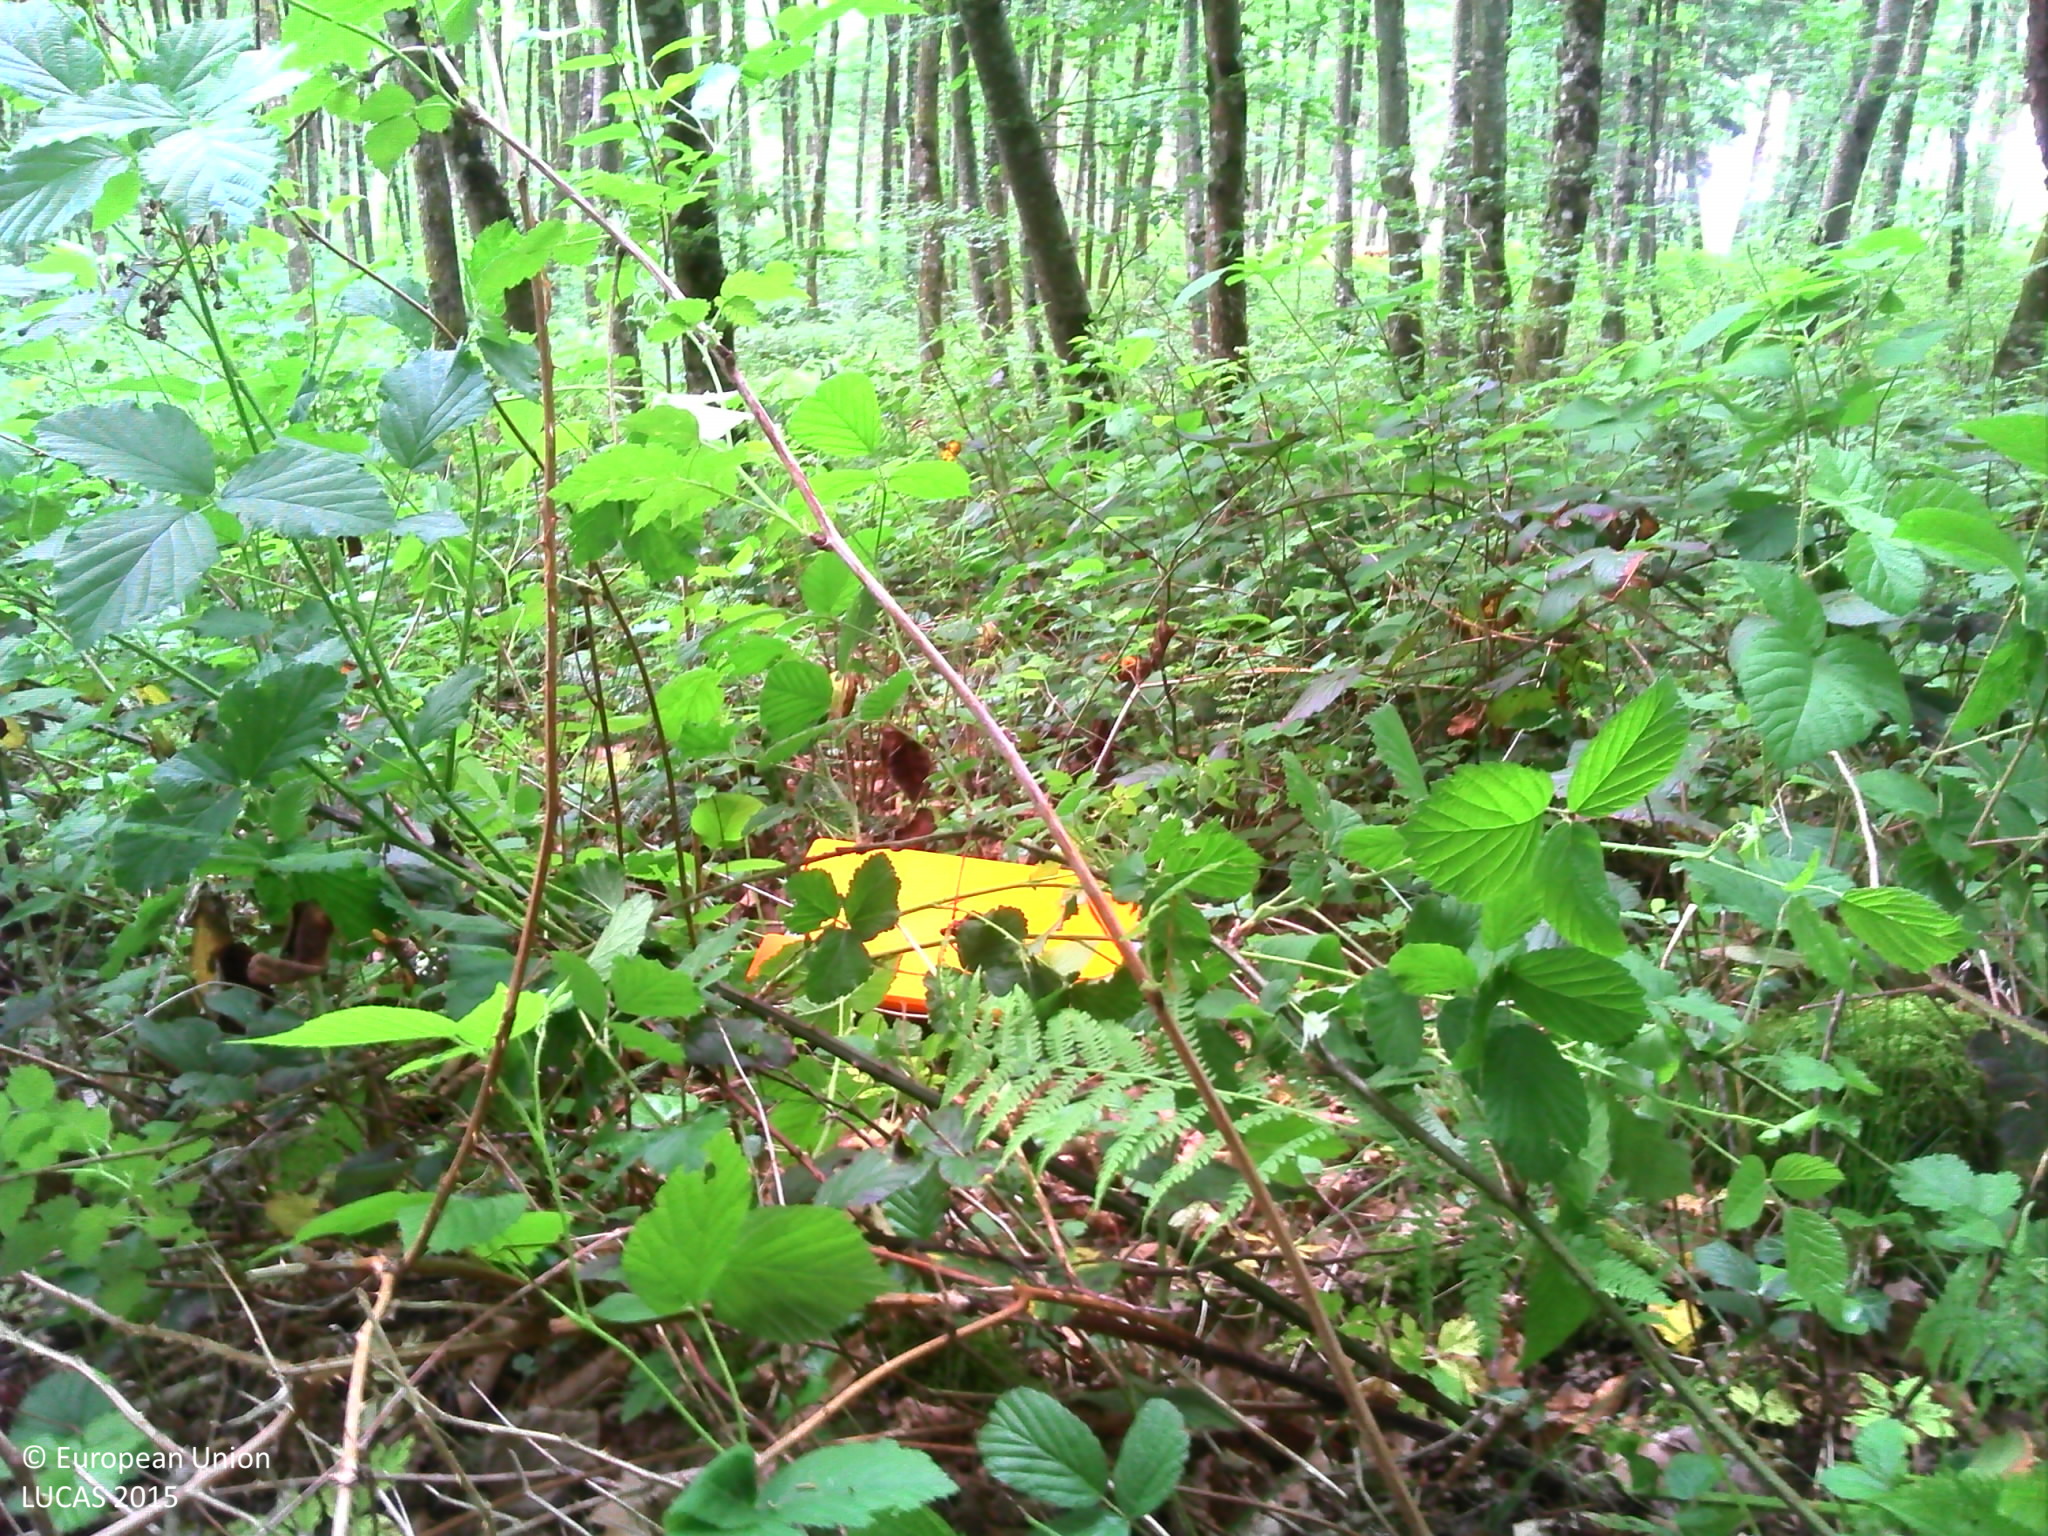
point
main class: Woodland
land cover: Broadleaved woodland
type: beech forest
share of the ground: > 75 %
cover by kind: broadleaved forest trees 90 %, herbaceous plants 10 %
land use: Forestry
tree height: > 5 m
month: May
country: FR
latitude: 47.8629
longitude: 6.0040
